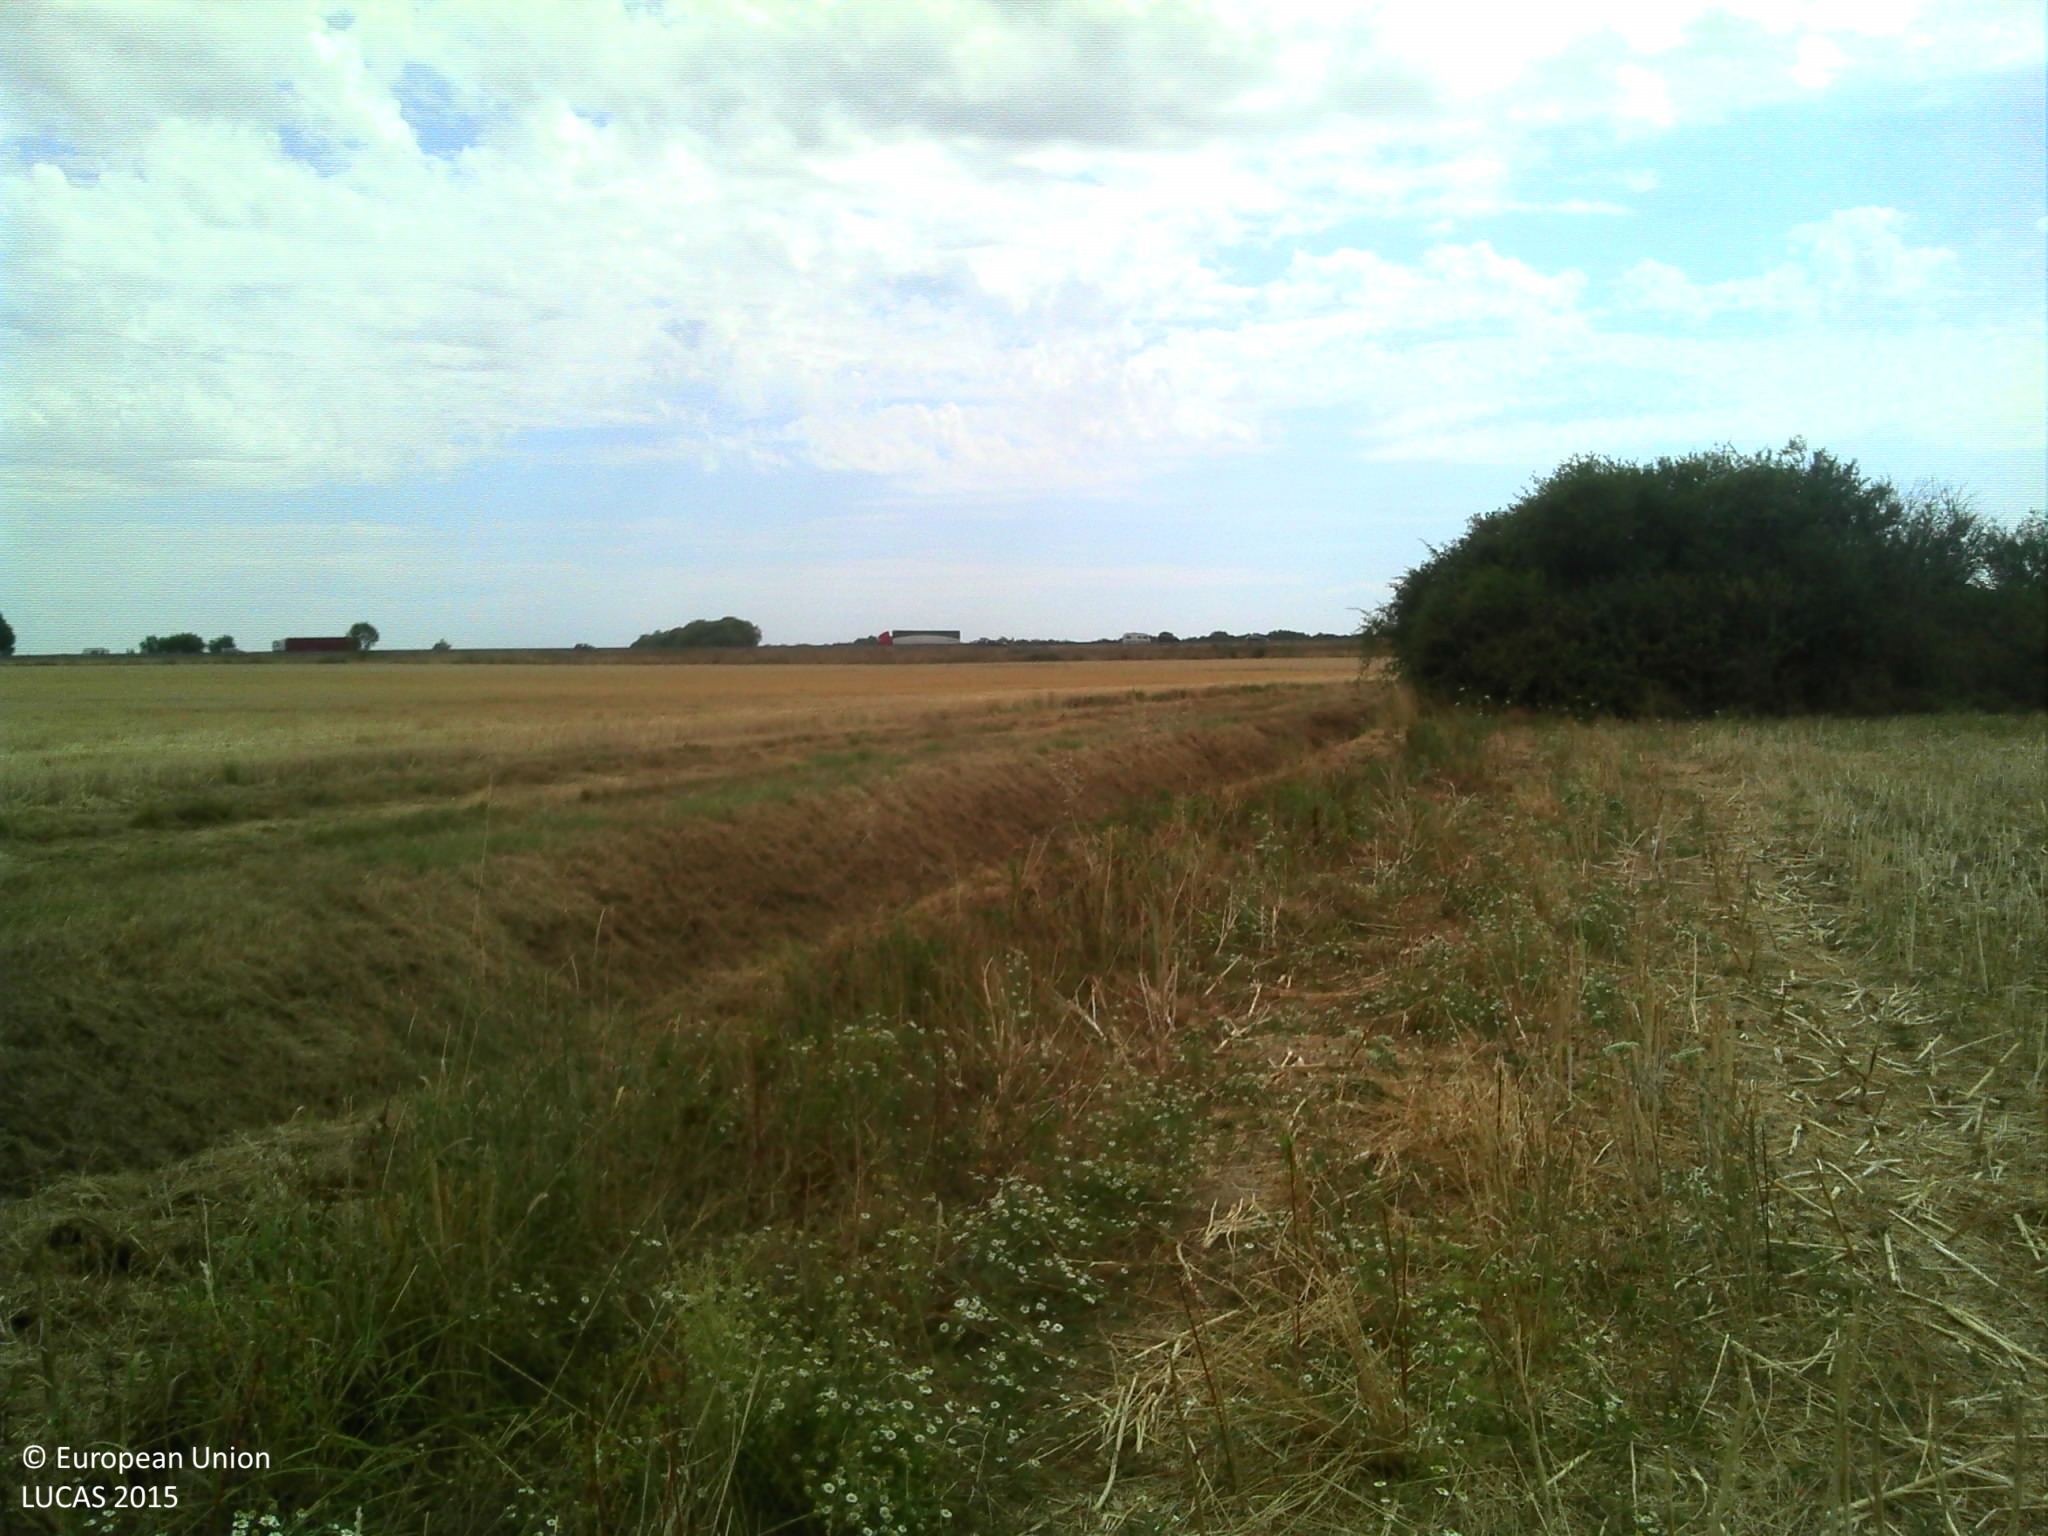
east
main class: Cropland
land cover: Rape and turnip rape
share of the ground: < 10 %
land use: Agriculture (excluding fallow land and kitchen gardens)
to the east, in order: Rape and turnip rape; Grass margins; Ditches and canals; Tracks; Ditches and canals; Common wheat; Ditches and canals; Rape and turnip rape
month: July
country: FR
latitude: 46.9112
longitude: 4.8148
